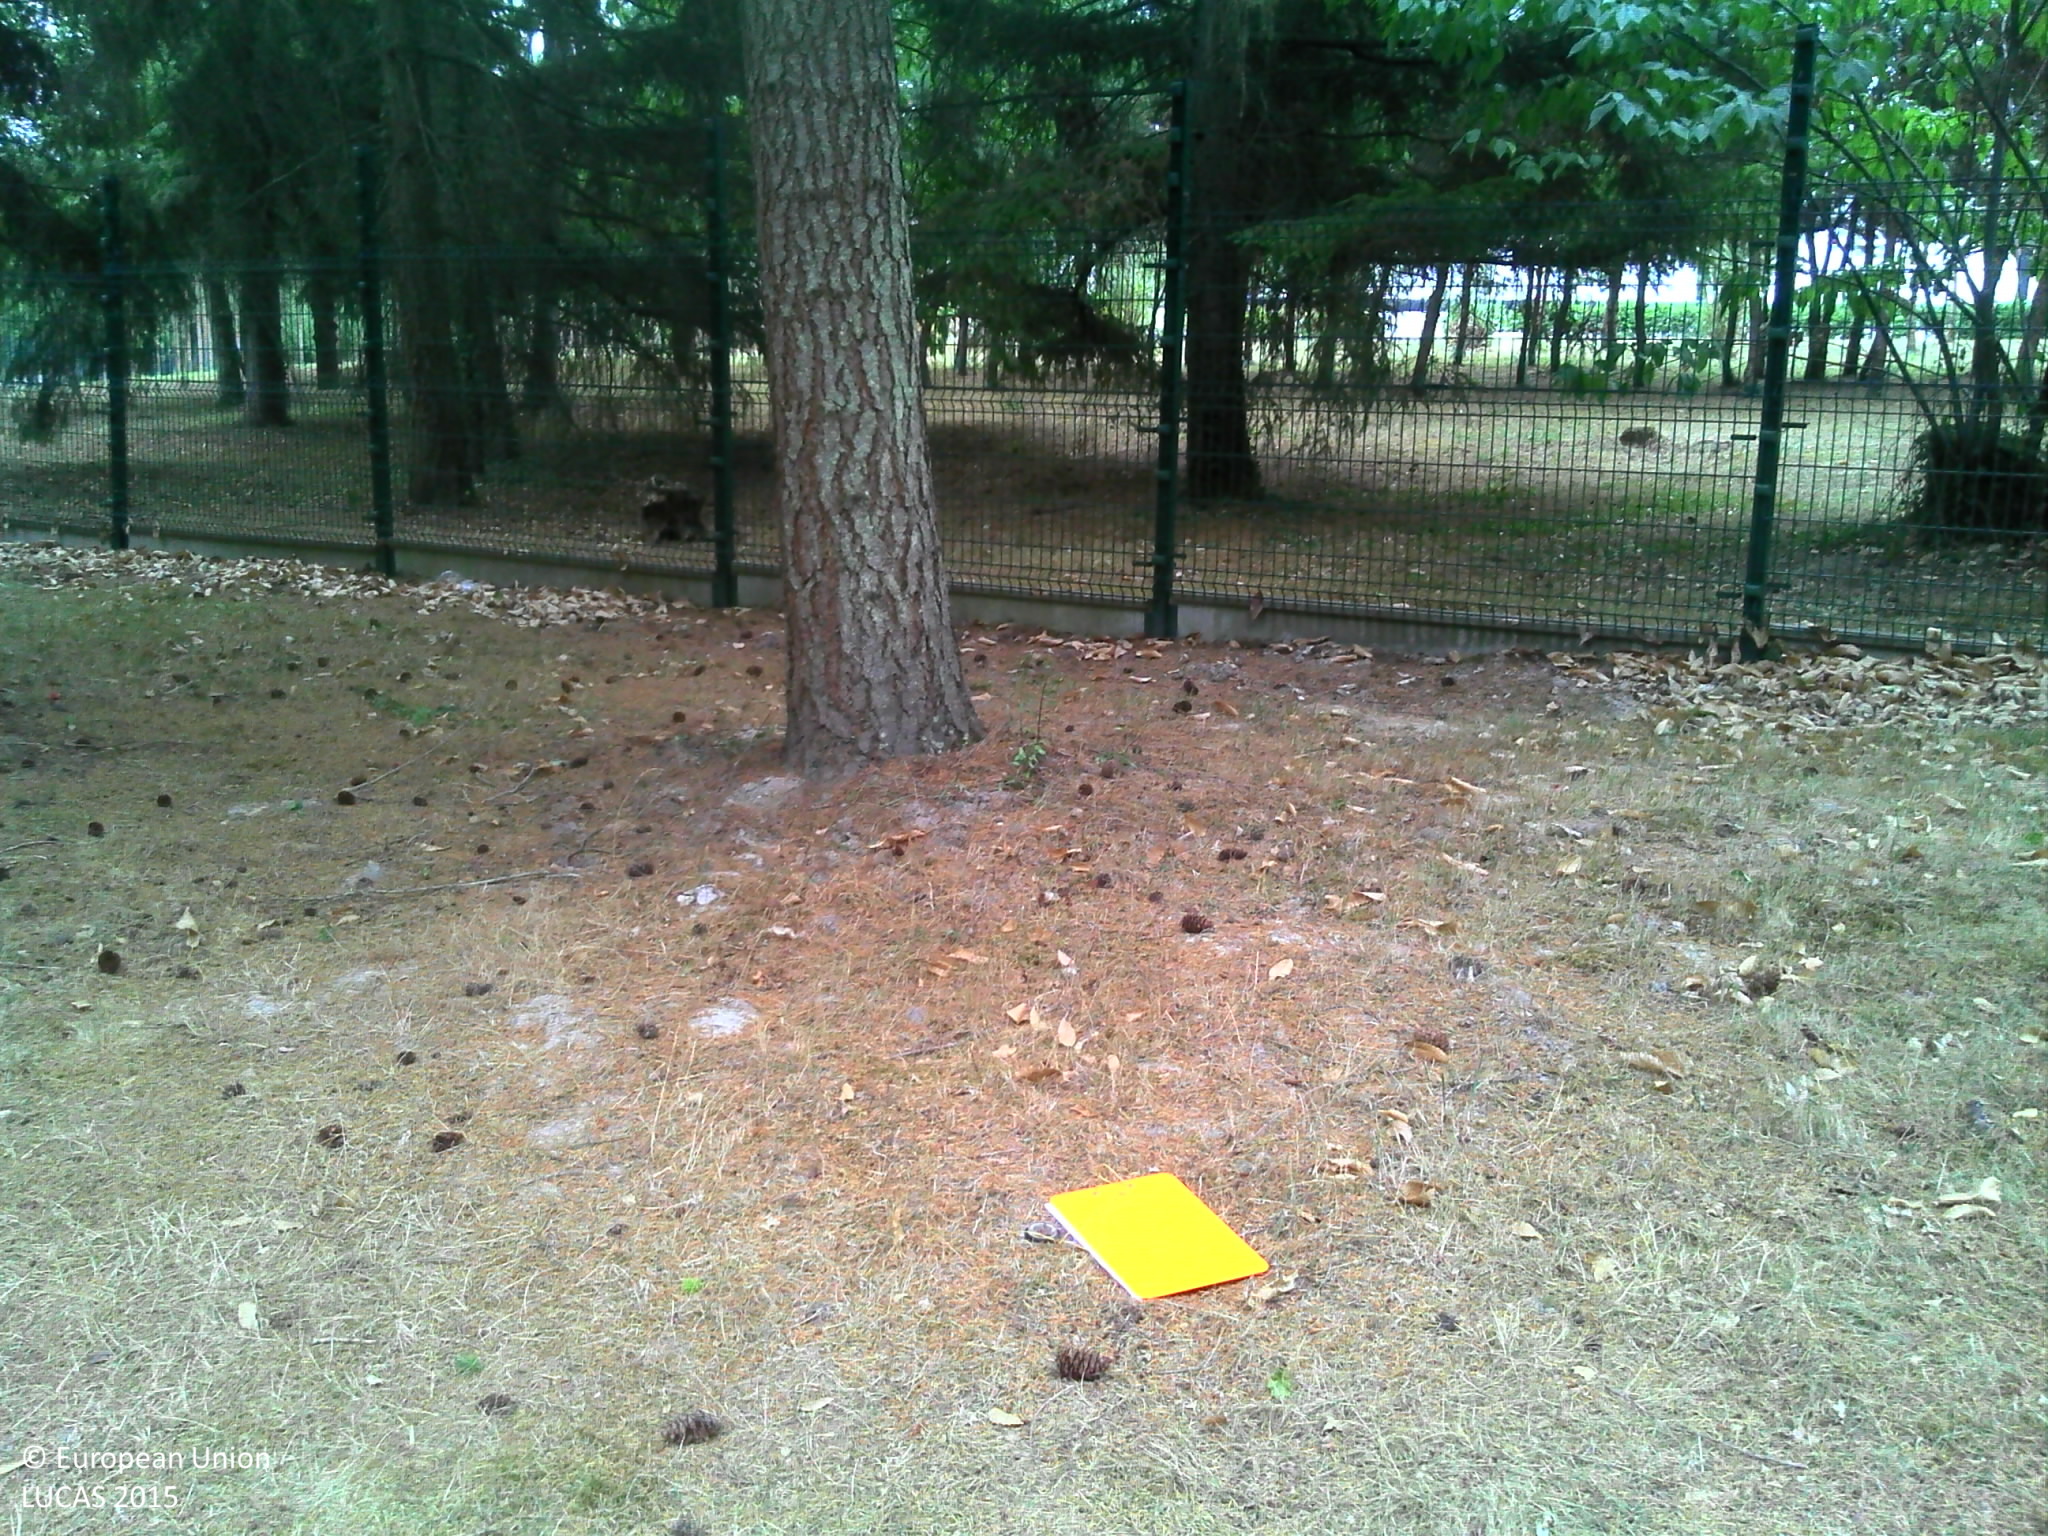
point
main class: Woodland
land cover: Spruce dominated coniferous woodland
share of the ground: > 75 %
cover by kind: coniferous forest trees 100 %
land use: Amenities, museums, leisure
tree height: > 5 m
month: July
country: FR
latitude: 47.9323
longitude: 1.9970
